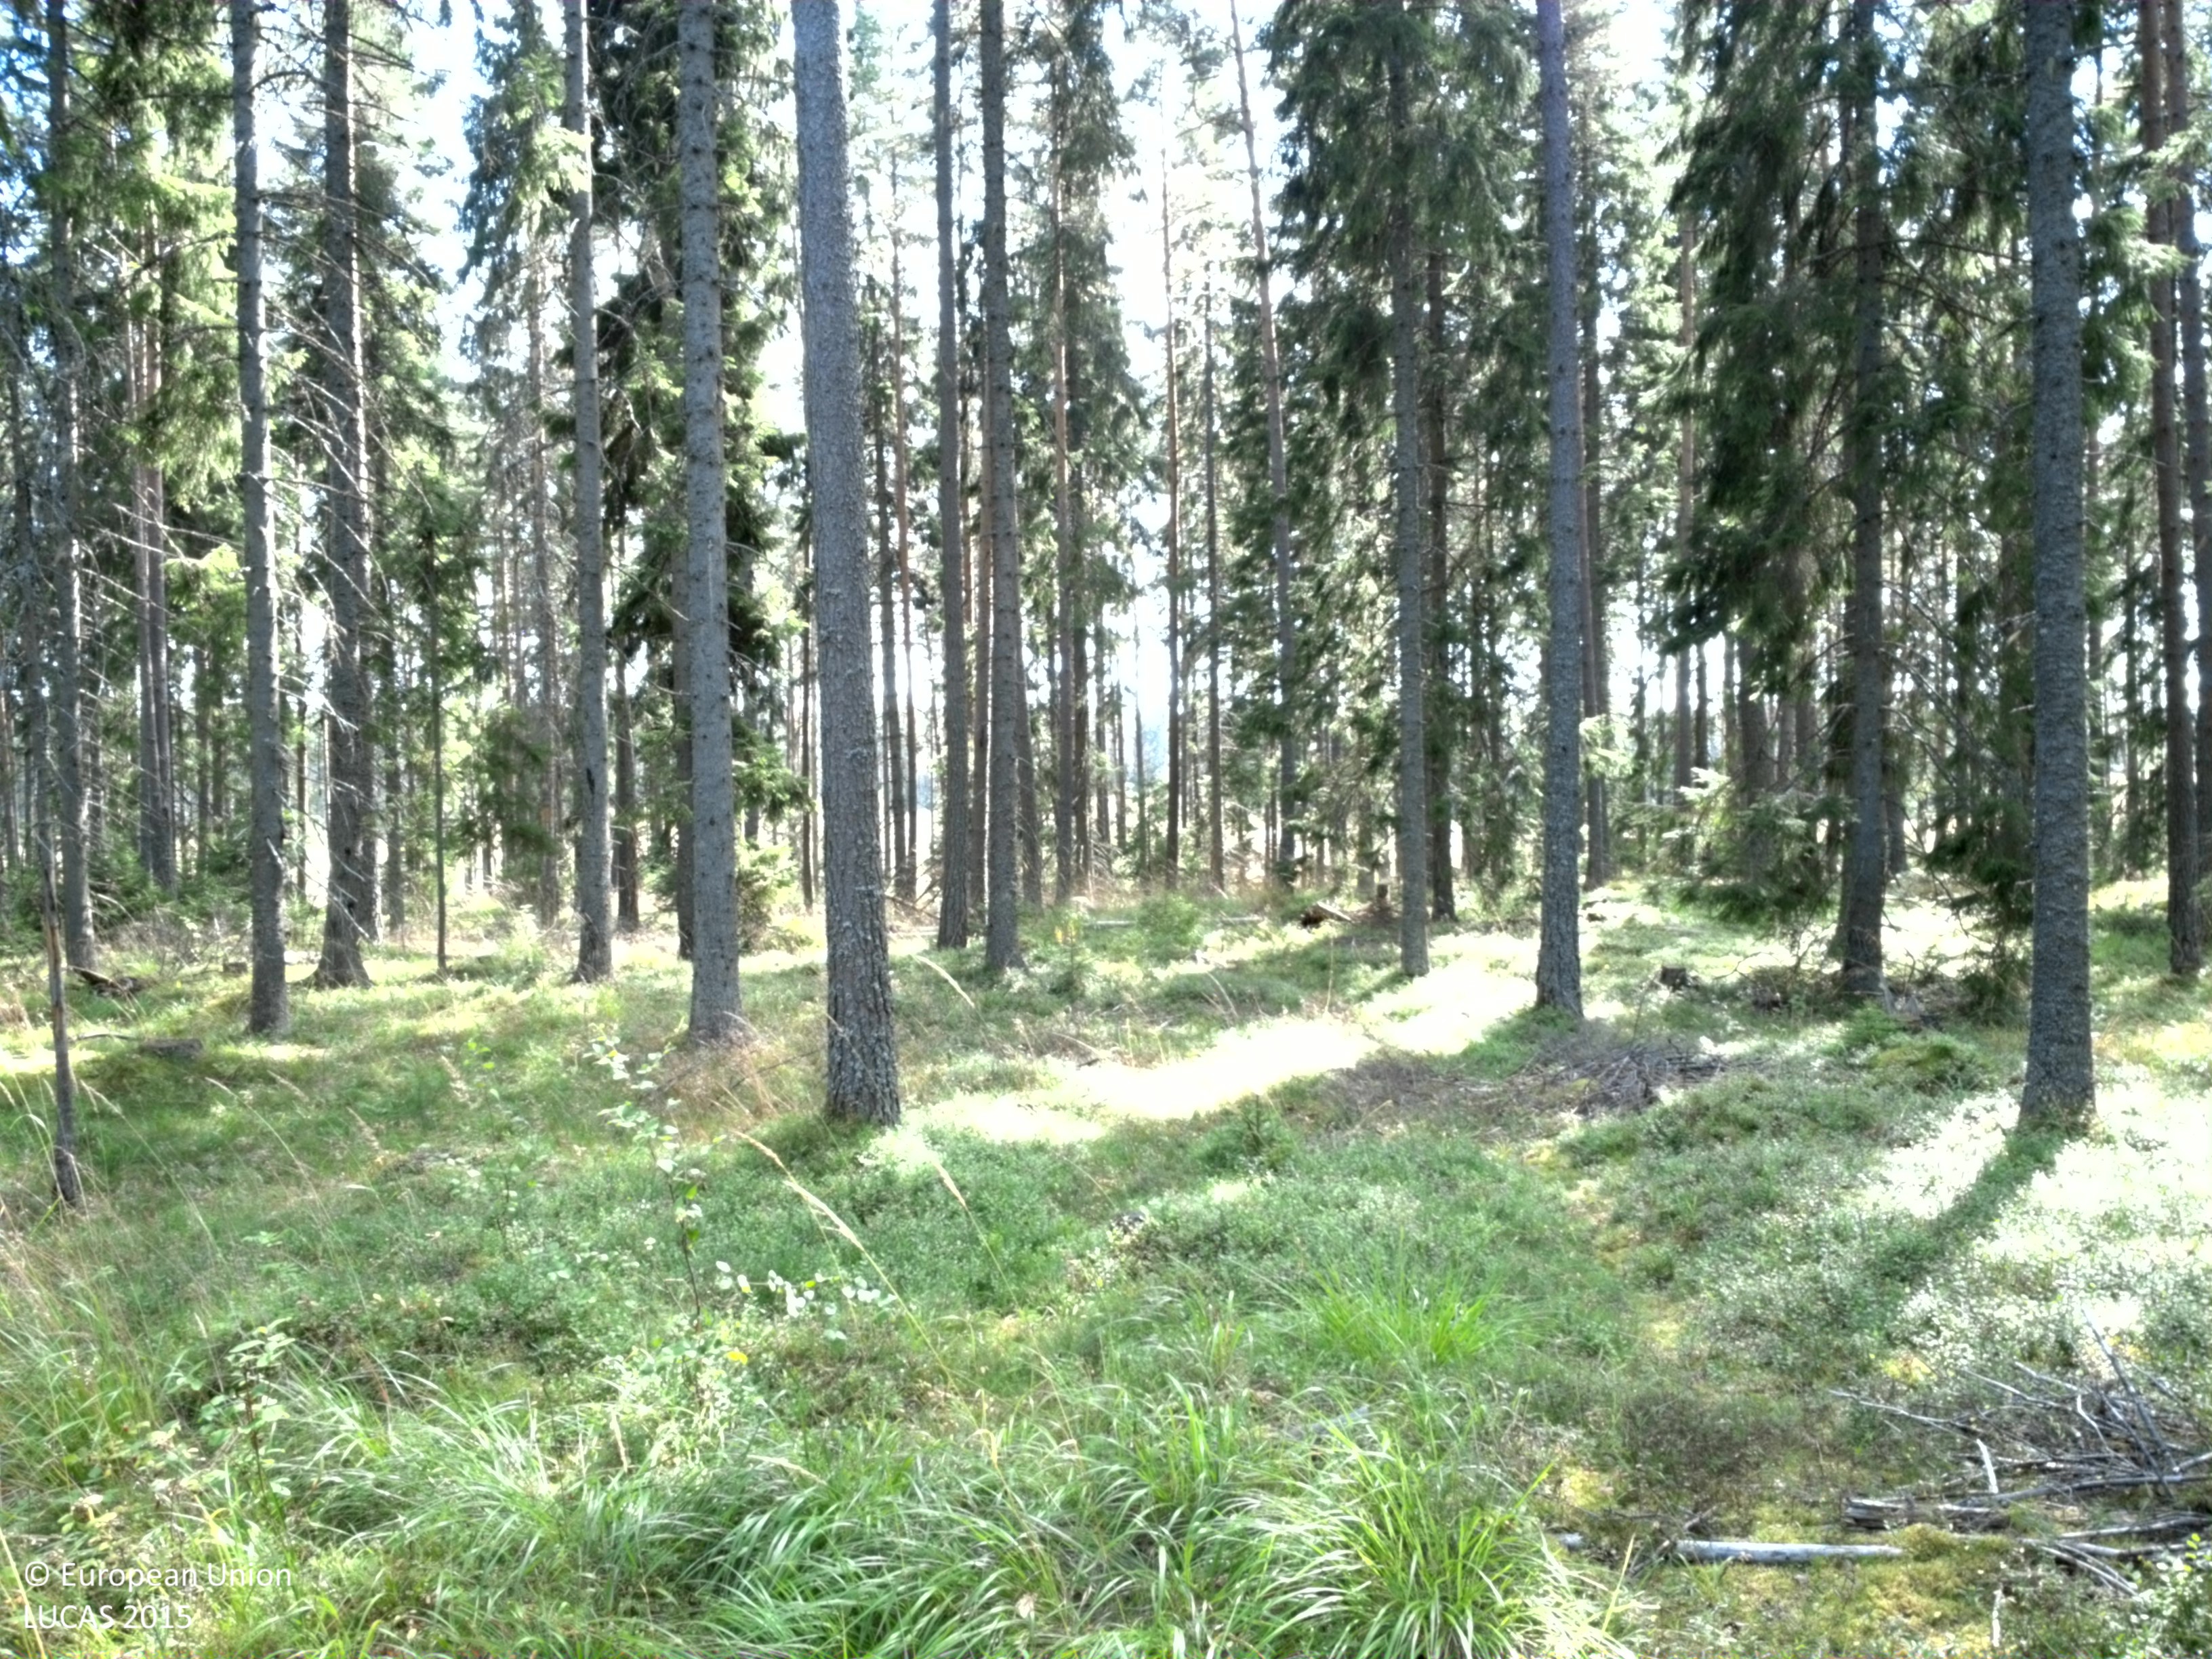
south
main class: Woodland
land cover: Pine dominated coniferous woodland
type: boreal forest
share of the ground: 25 - 50 %
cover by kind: coniferous forest trees 40 %, shrubs 25 %, herbaceous plants 15 %, lichens and mosses 15 %, broadleaved forest trees 5 %
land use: Forestry
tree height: > 5 m
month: August
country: SE
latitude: 60.1162
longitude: 18.0017
